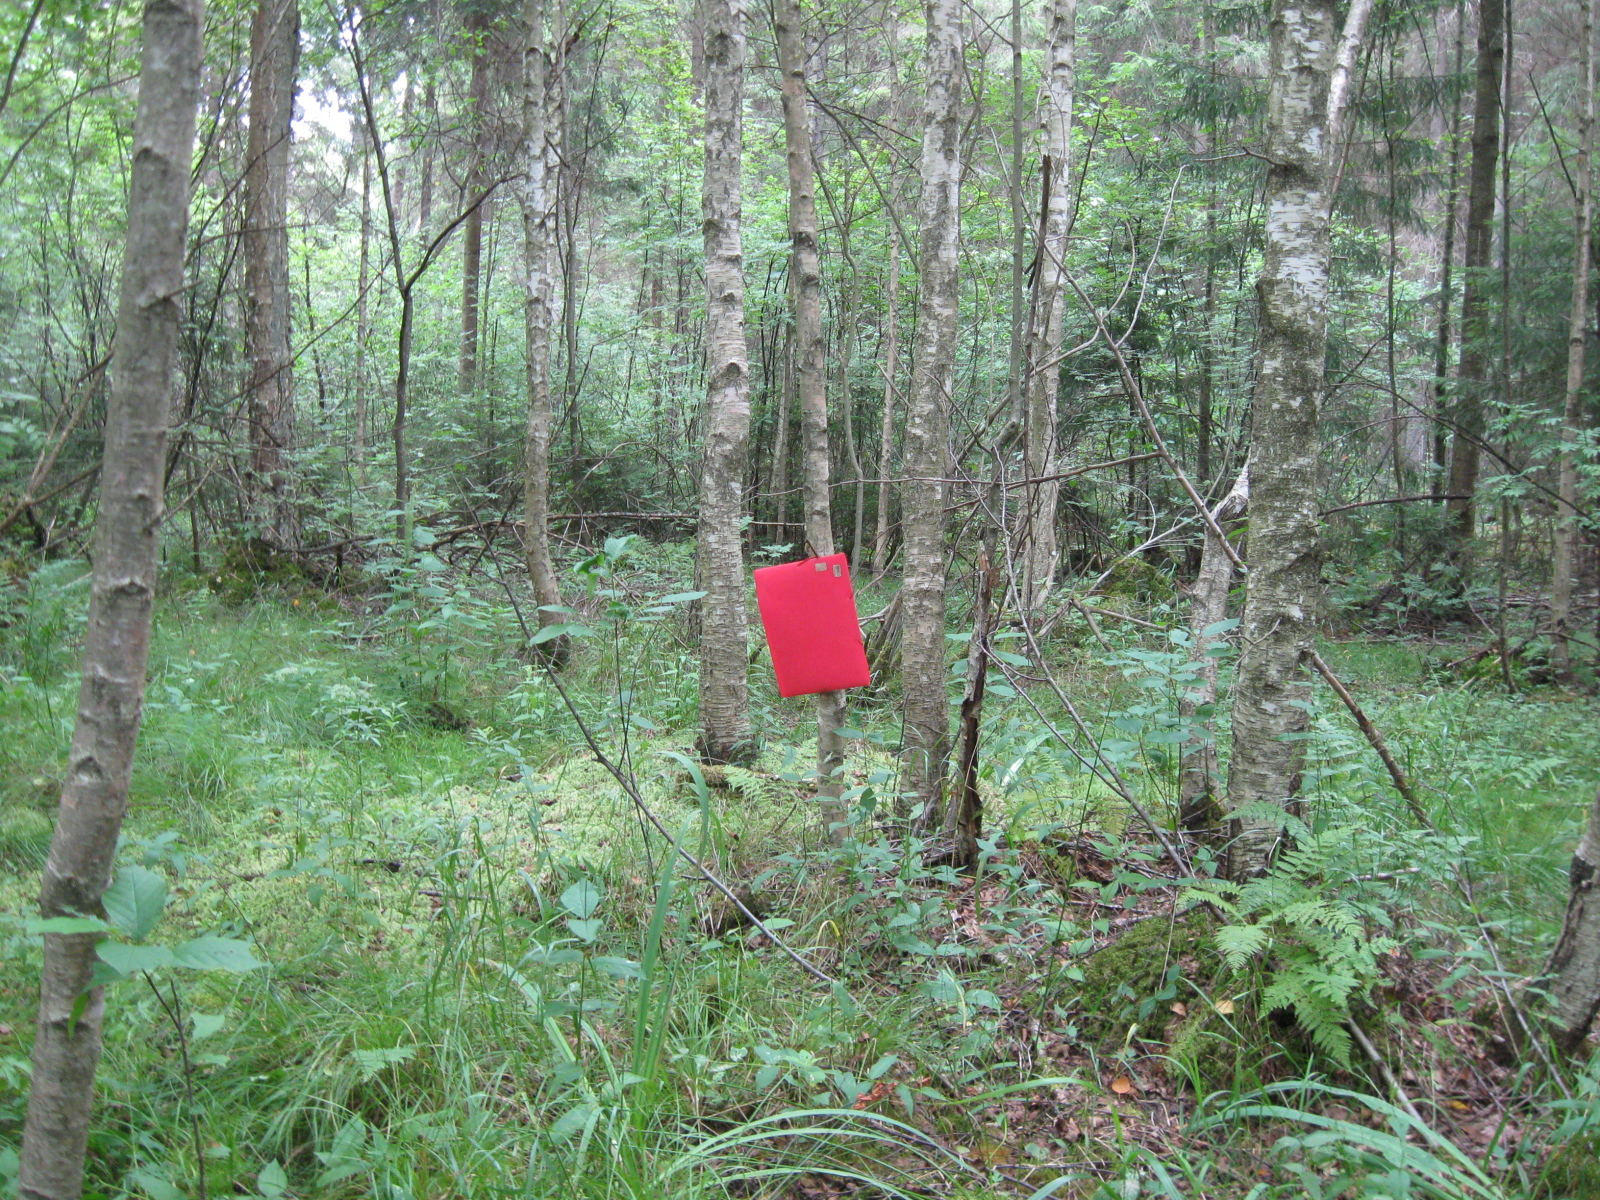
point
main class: Woodland
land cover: Broadleaved woodland
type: non-riverine alder, birch or aspen forest
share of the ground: > 75 %
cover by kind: broadleaved forest trees 75 %, herbaceous plants 10 %, coniferous forest trees 5 %, shrubs 5 %, lichens and mosses 5 %
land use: Forestry
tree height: > 5 m
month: July
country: LT
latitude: 54.7698
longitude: 23.5591
